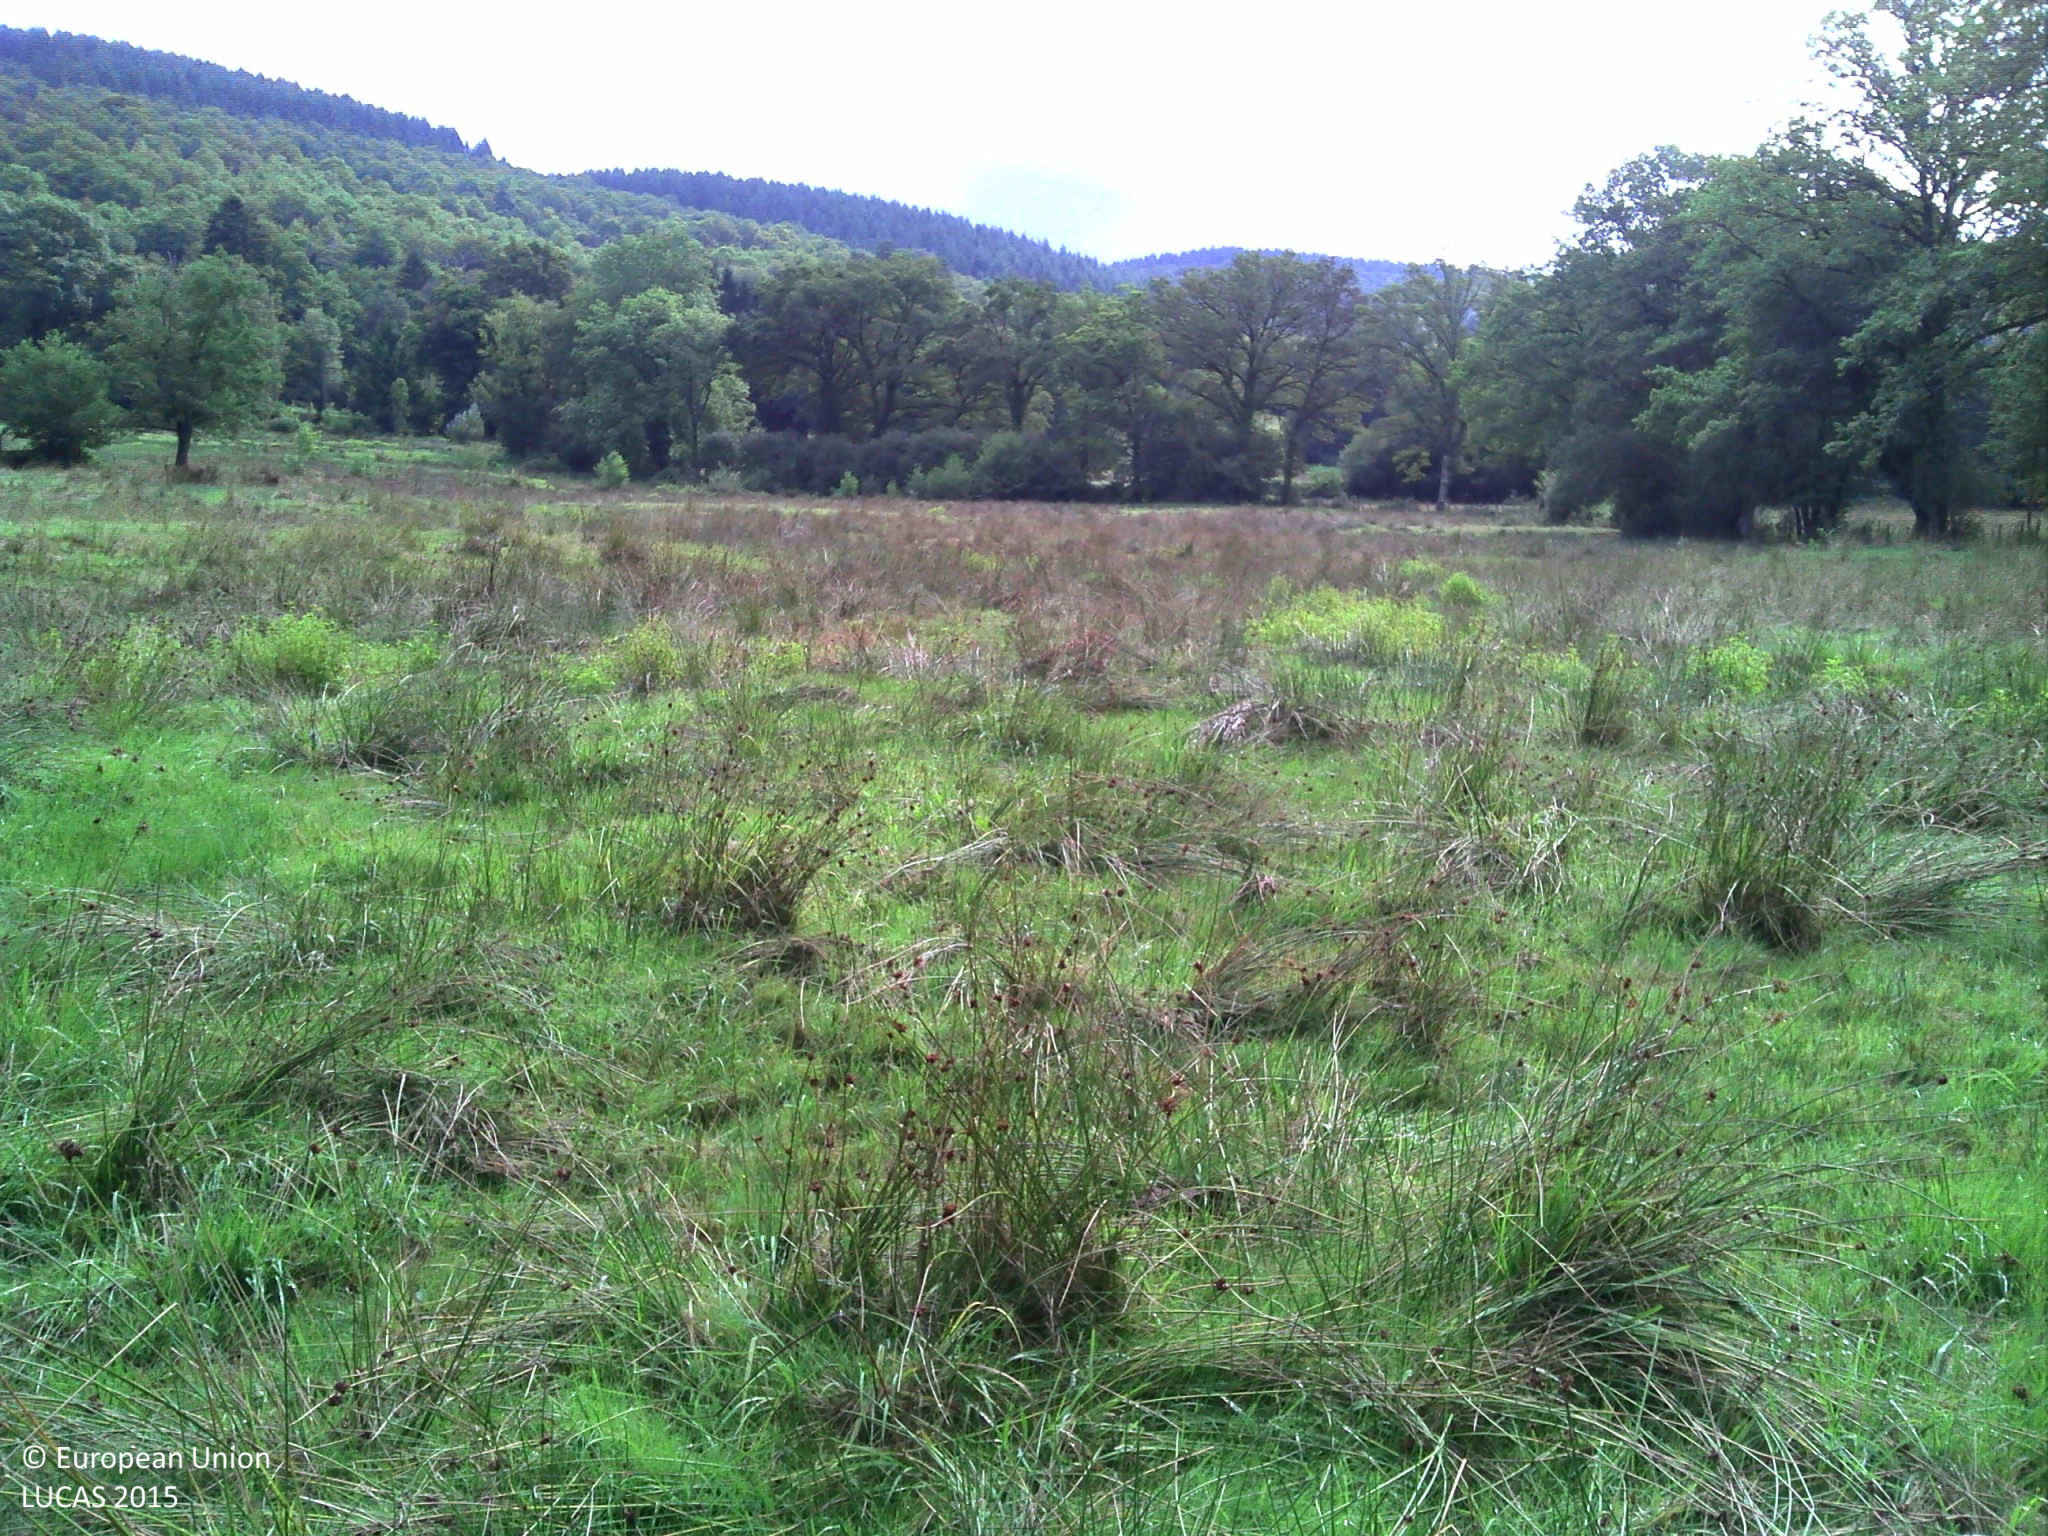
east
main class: Grassland
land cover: Grassland without tree/shrub cover
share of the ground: > 75 %
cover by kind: herbaceous plants 95 %, shrubs 5 %
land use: Agriculture (excluding fallow land and kitchen gardens)
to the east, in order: Grassland without tree/shrub cover; Broadleaved woodland; Fences; Grass margins; Paved roads, cycling and walking lanes; Grass margins; Ditches and canals; Fences; Lines of trees; Grassland without tree/shrub cover; Rivers and streams; Abandoned hedges; Single bushes/trees; Grassland without tree/shrub cover
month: August
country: FR
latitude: 45.5142
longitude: 1.8413
